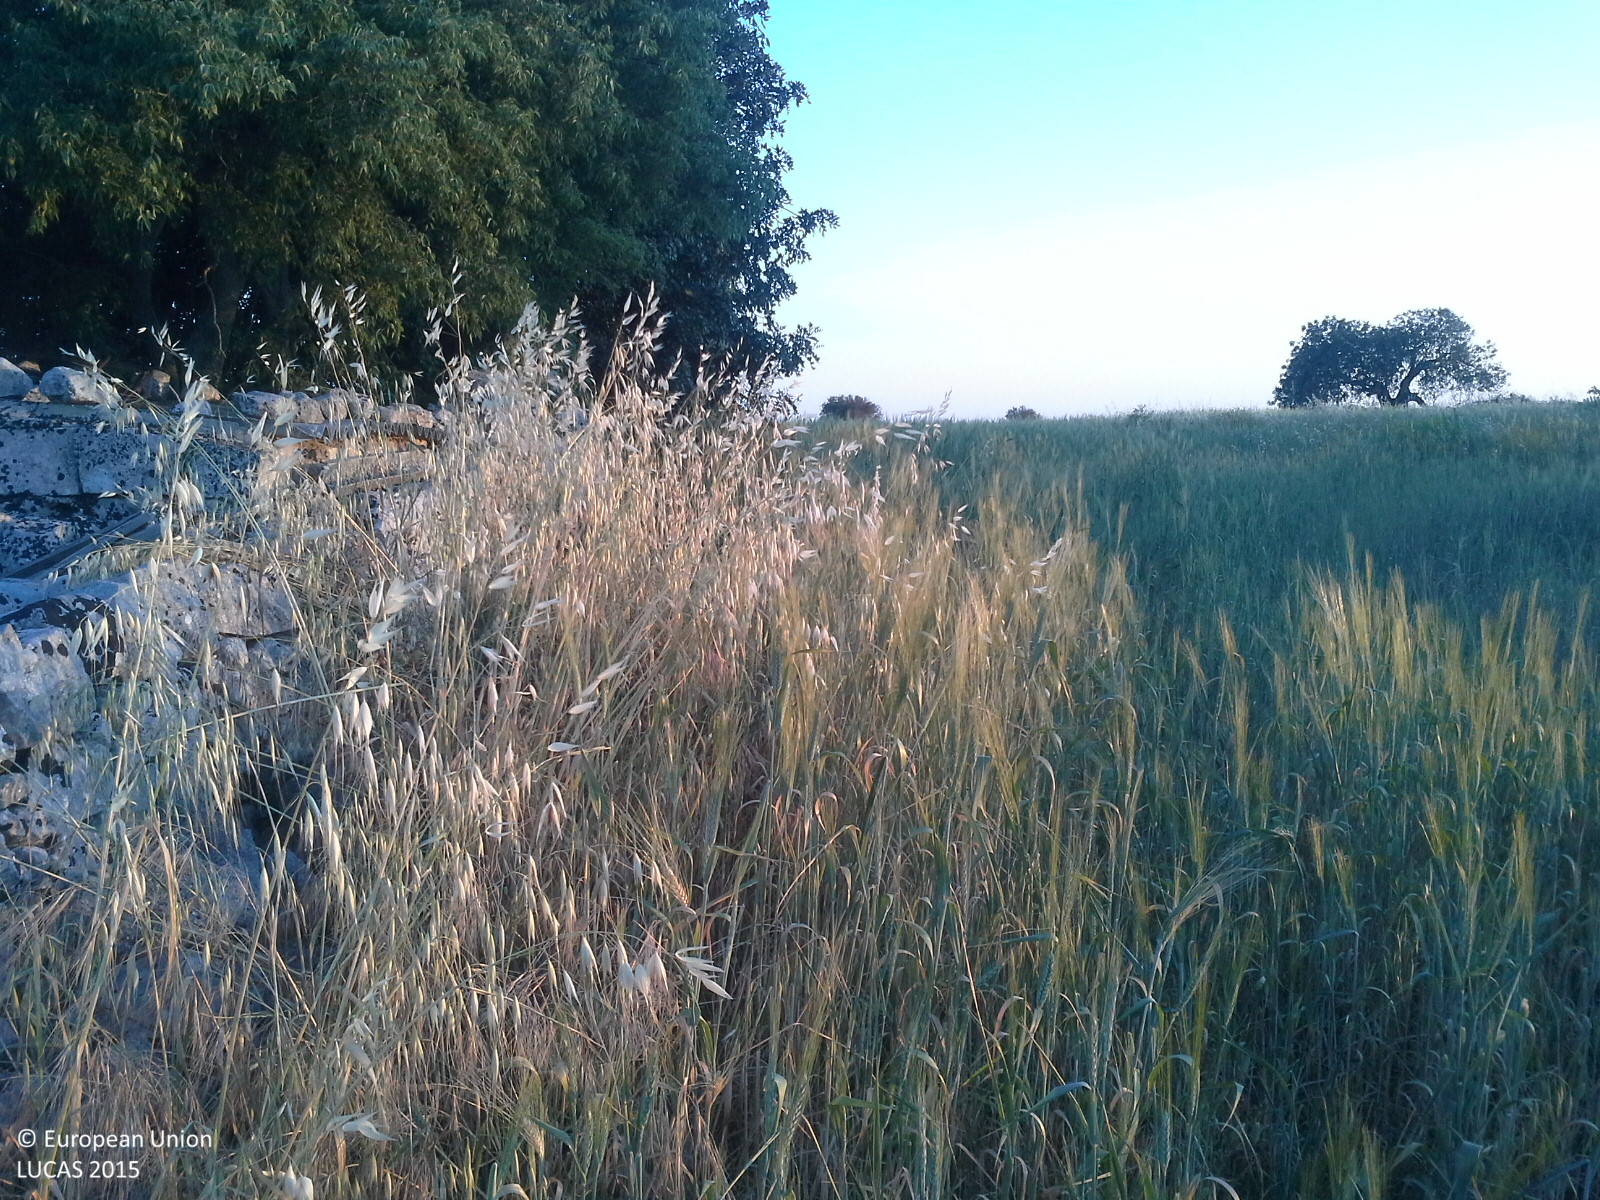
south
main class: Cropland
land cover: Durum wheat
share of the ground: > 75 %
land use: Agriculture (excluding fallow land and kitchen gardens)
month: May
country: IT
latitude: 36.8251
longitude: 14.8159
